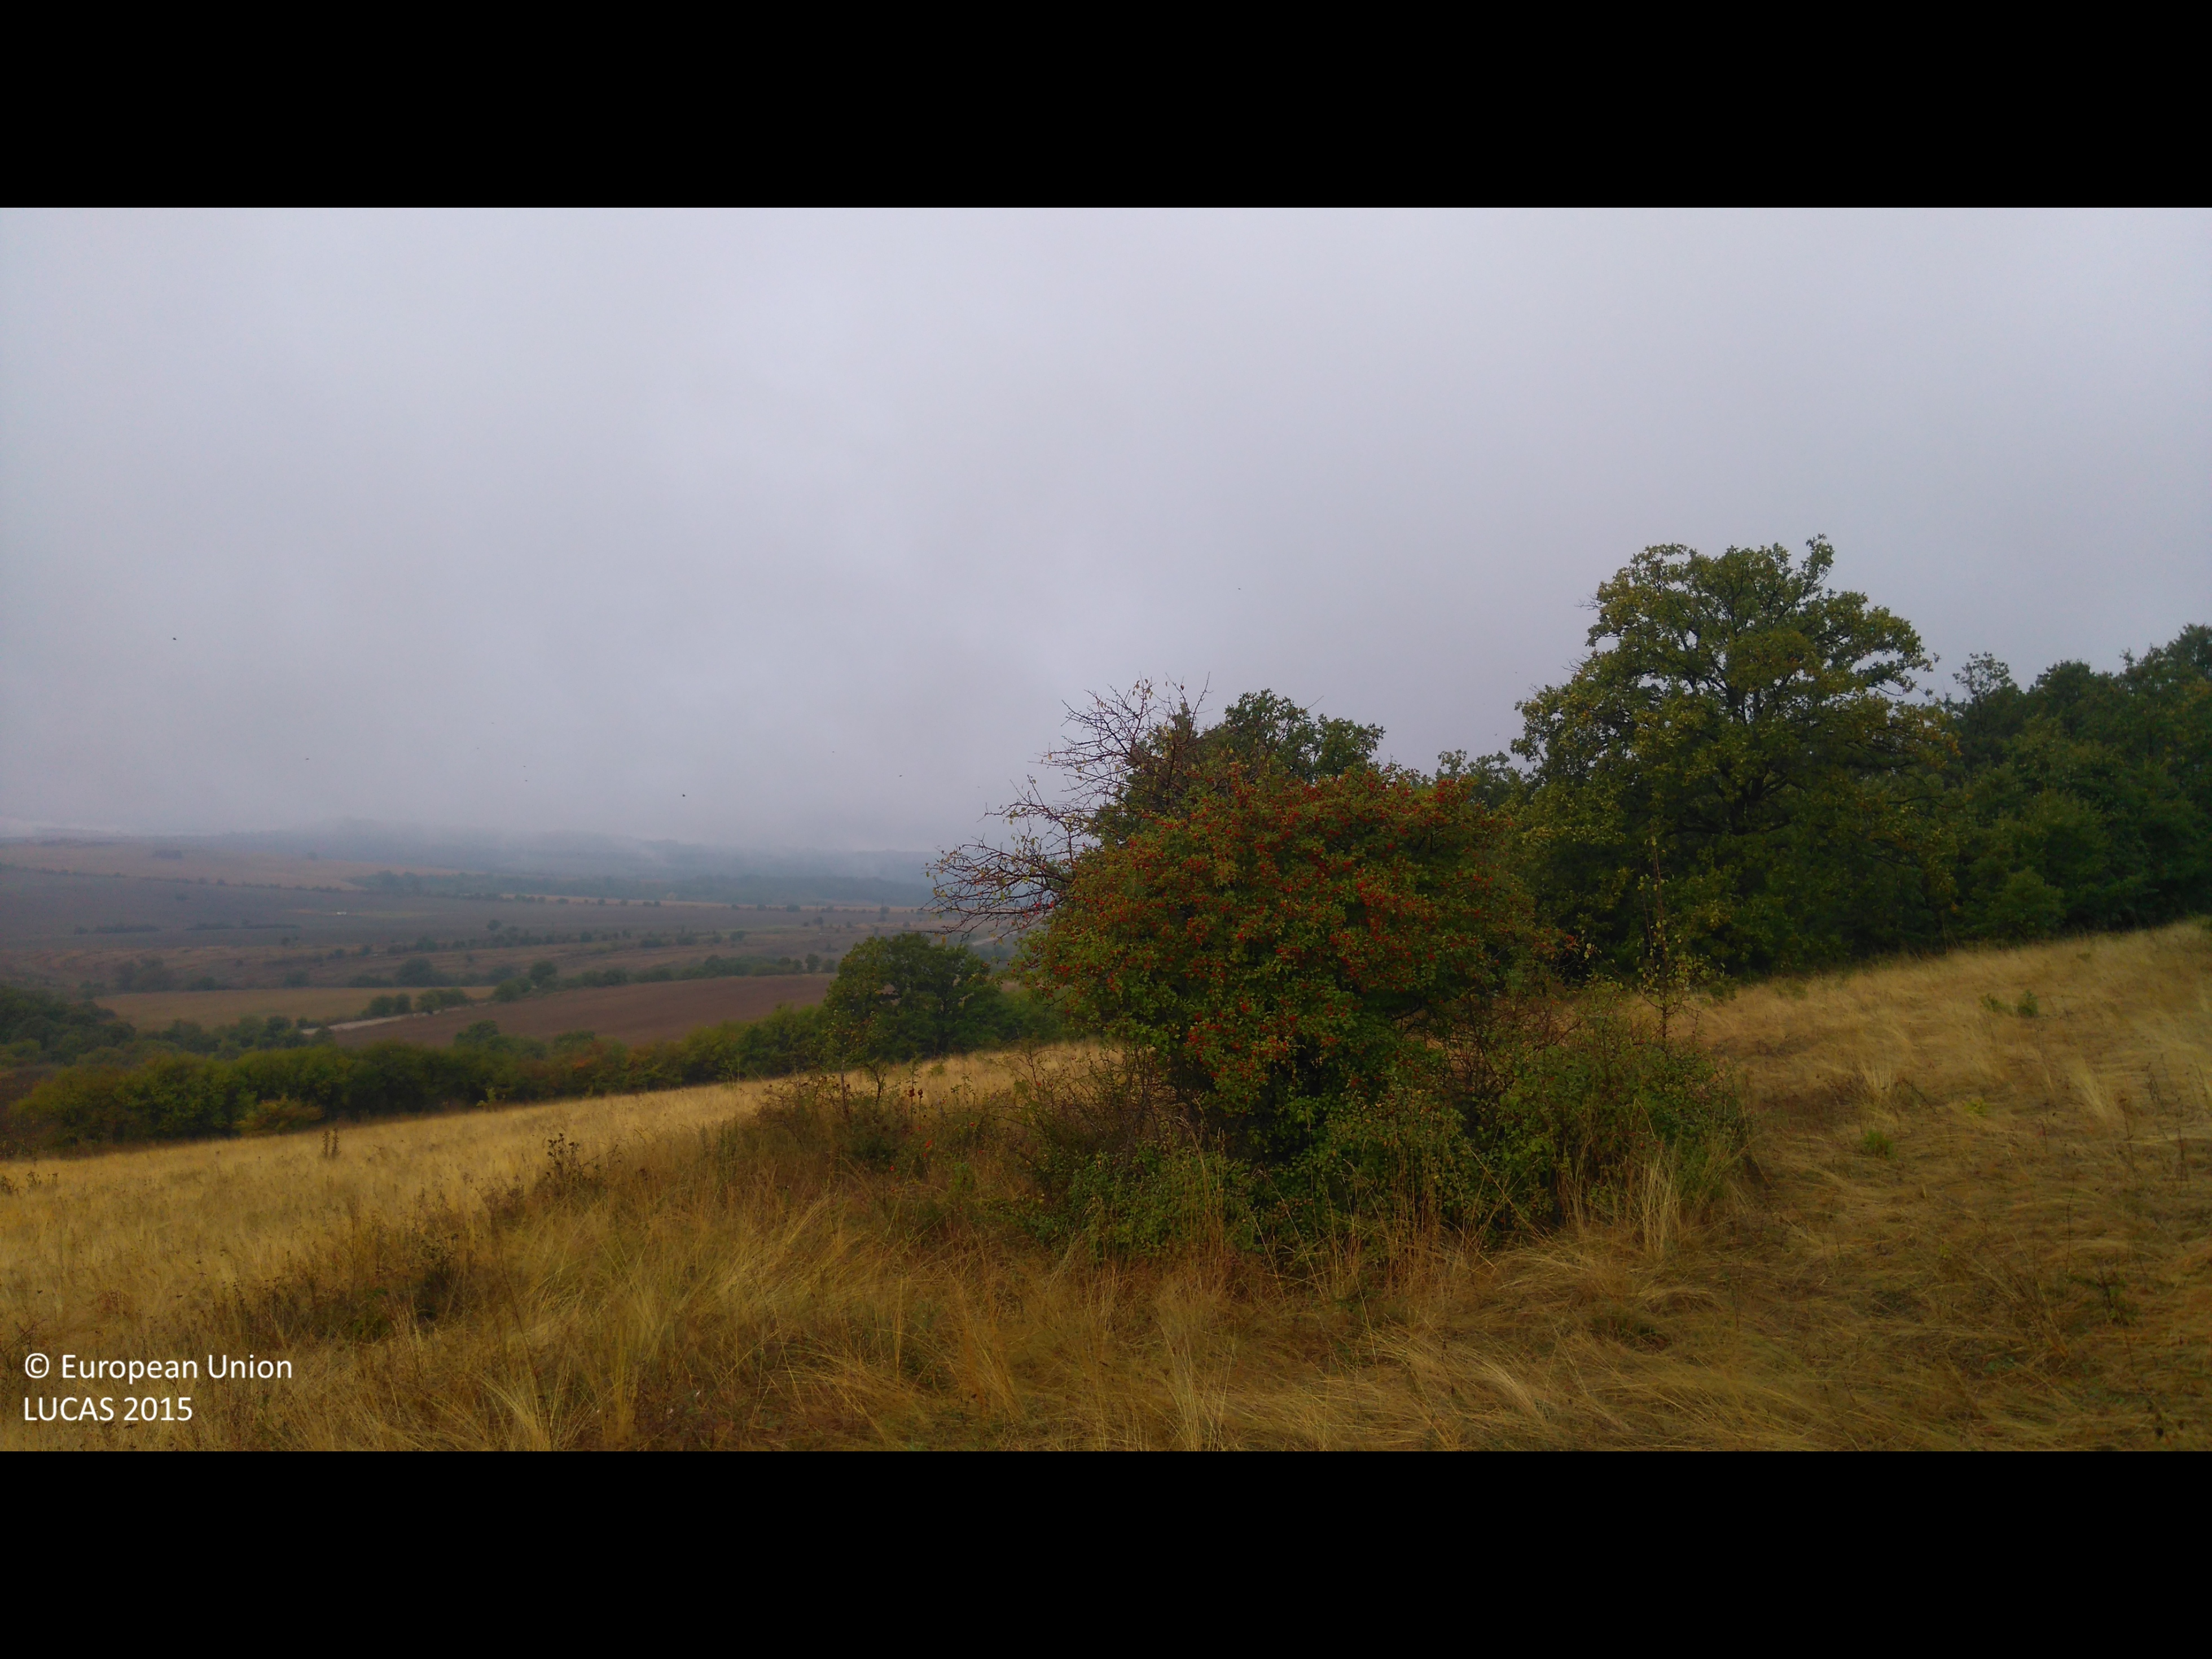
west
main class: Grassland
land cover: Grassland with sparse tree/shrub cover
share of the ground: > 75 %
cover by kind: herbaceous plants 90 %, broadleaved forest trees 5 %, shrubs 5 %
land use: Agriculture (excluding fallow land and kitchen gardens)
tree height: > 5 m
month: October
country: BG
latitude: 42.6504
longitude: 23.8373
